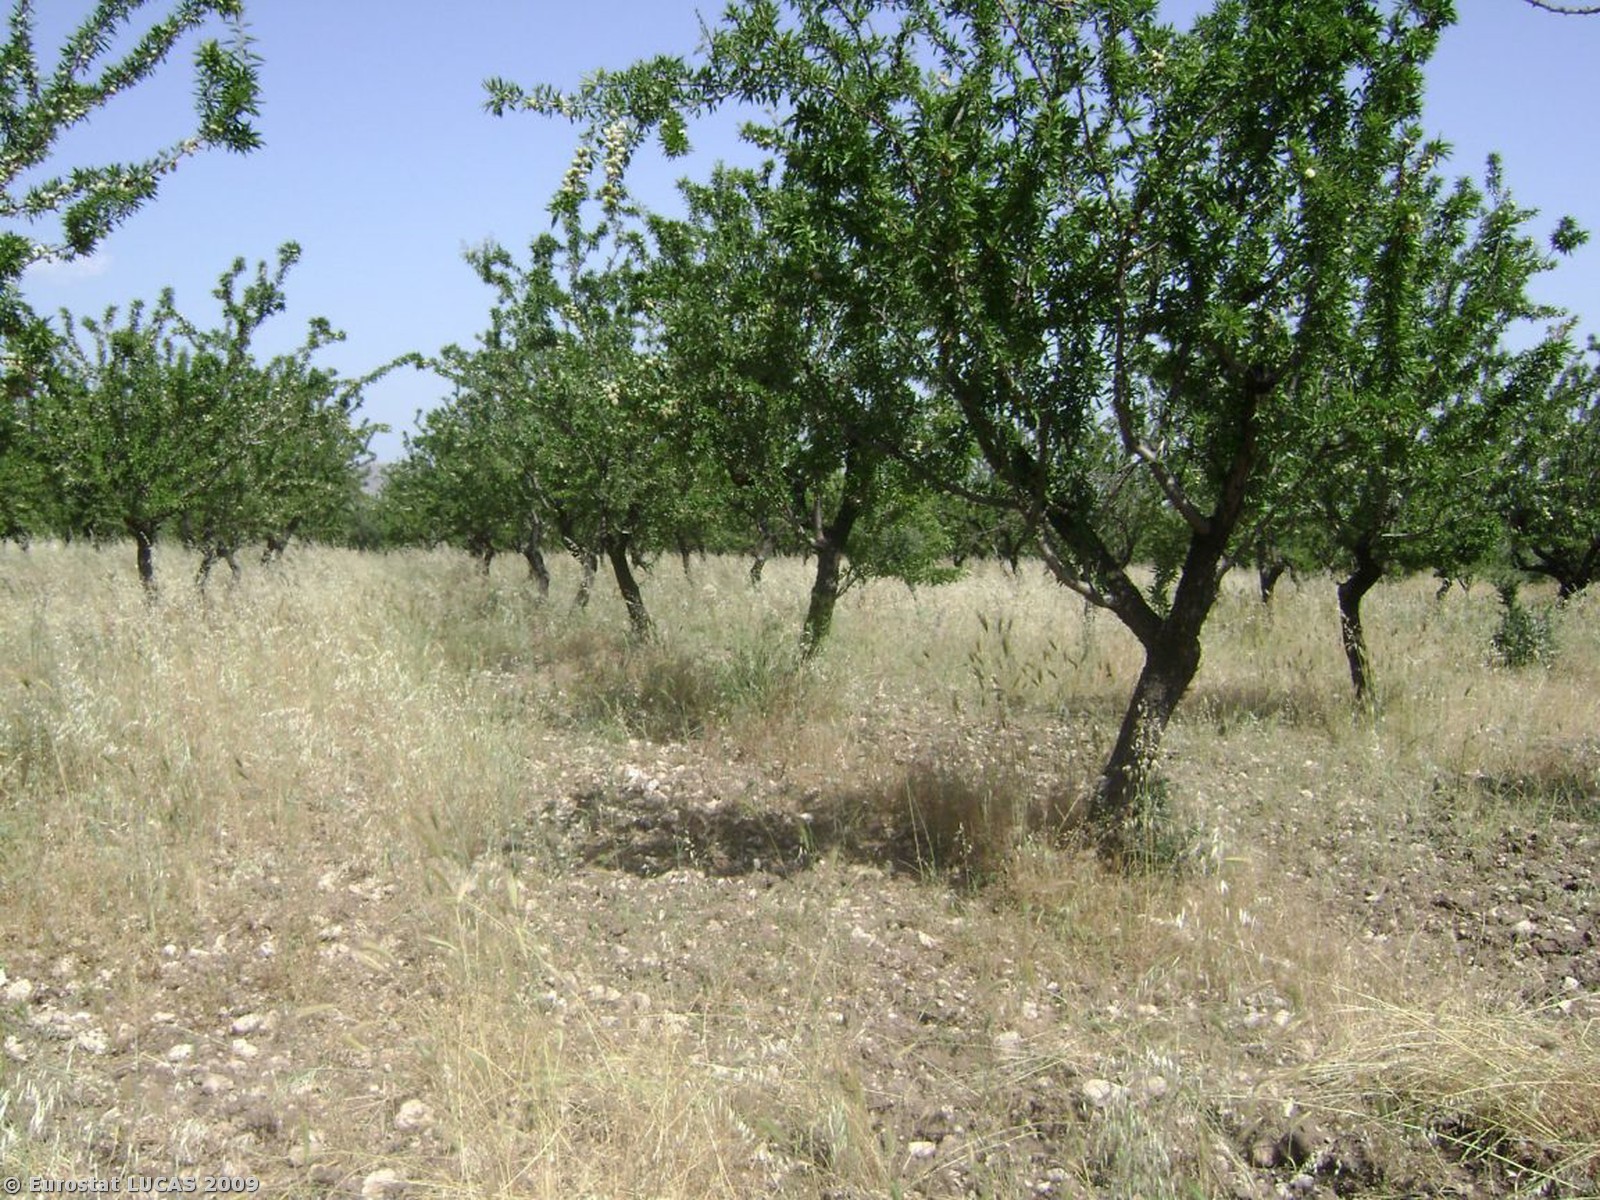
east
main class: Cropland
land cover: Nuts trees
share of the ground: 25 - 50 %
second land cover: Spontaneously vegetated surfaces
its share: > 75 %
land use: Agriculture (excluding fallow land and kitchen gardens)
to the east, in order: Nuts trees; Spontaneously vegetated surfaces; Nuts trees; Bare land; Olive groves; Spontaneously vegetated surfaces; Olive groves; Spontaneously vegetated surfaces
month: May
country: IT
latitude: 41.6613
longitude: 15.6871
